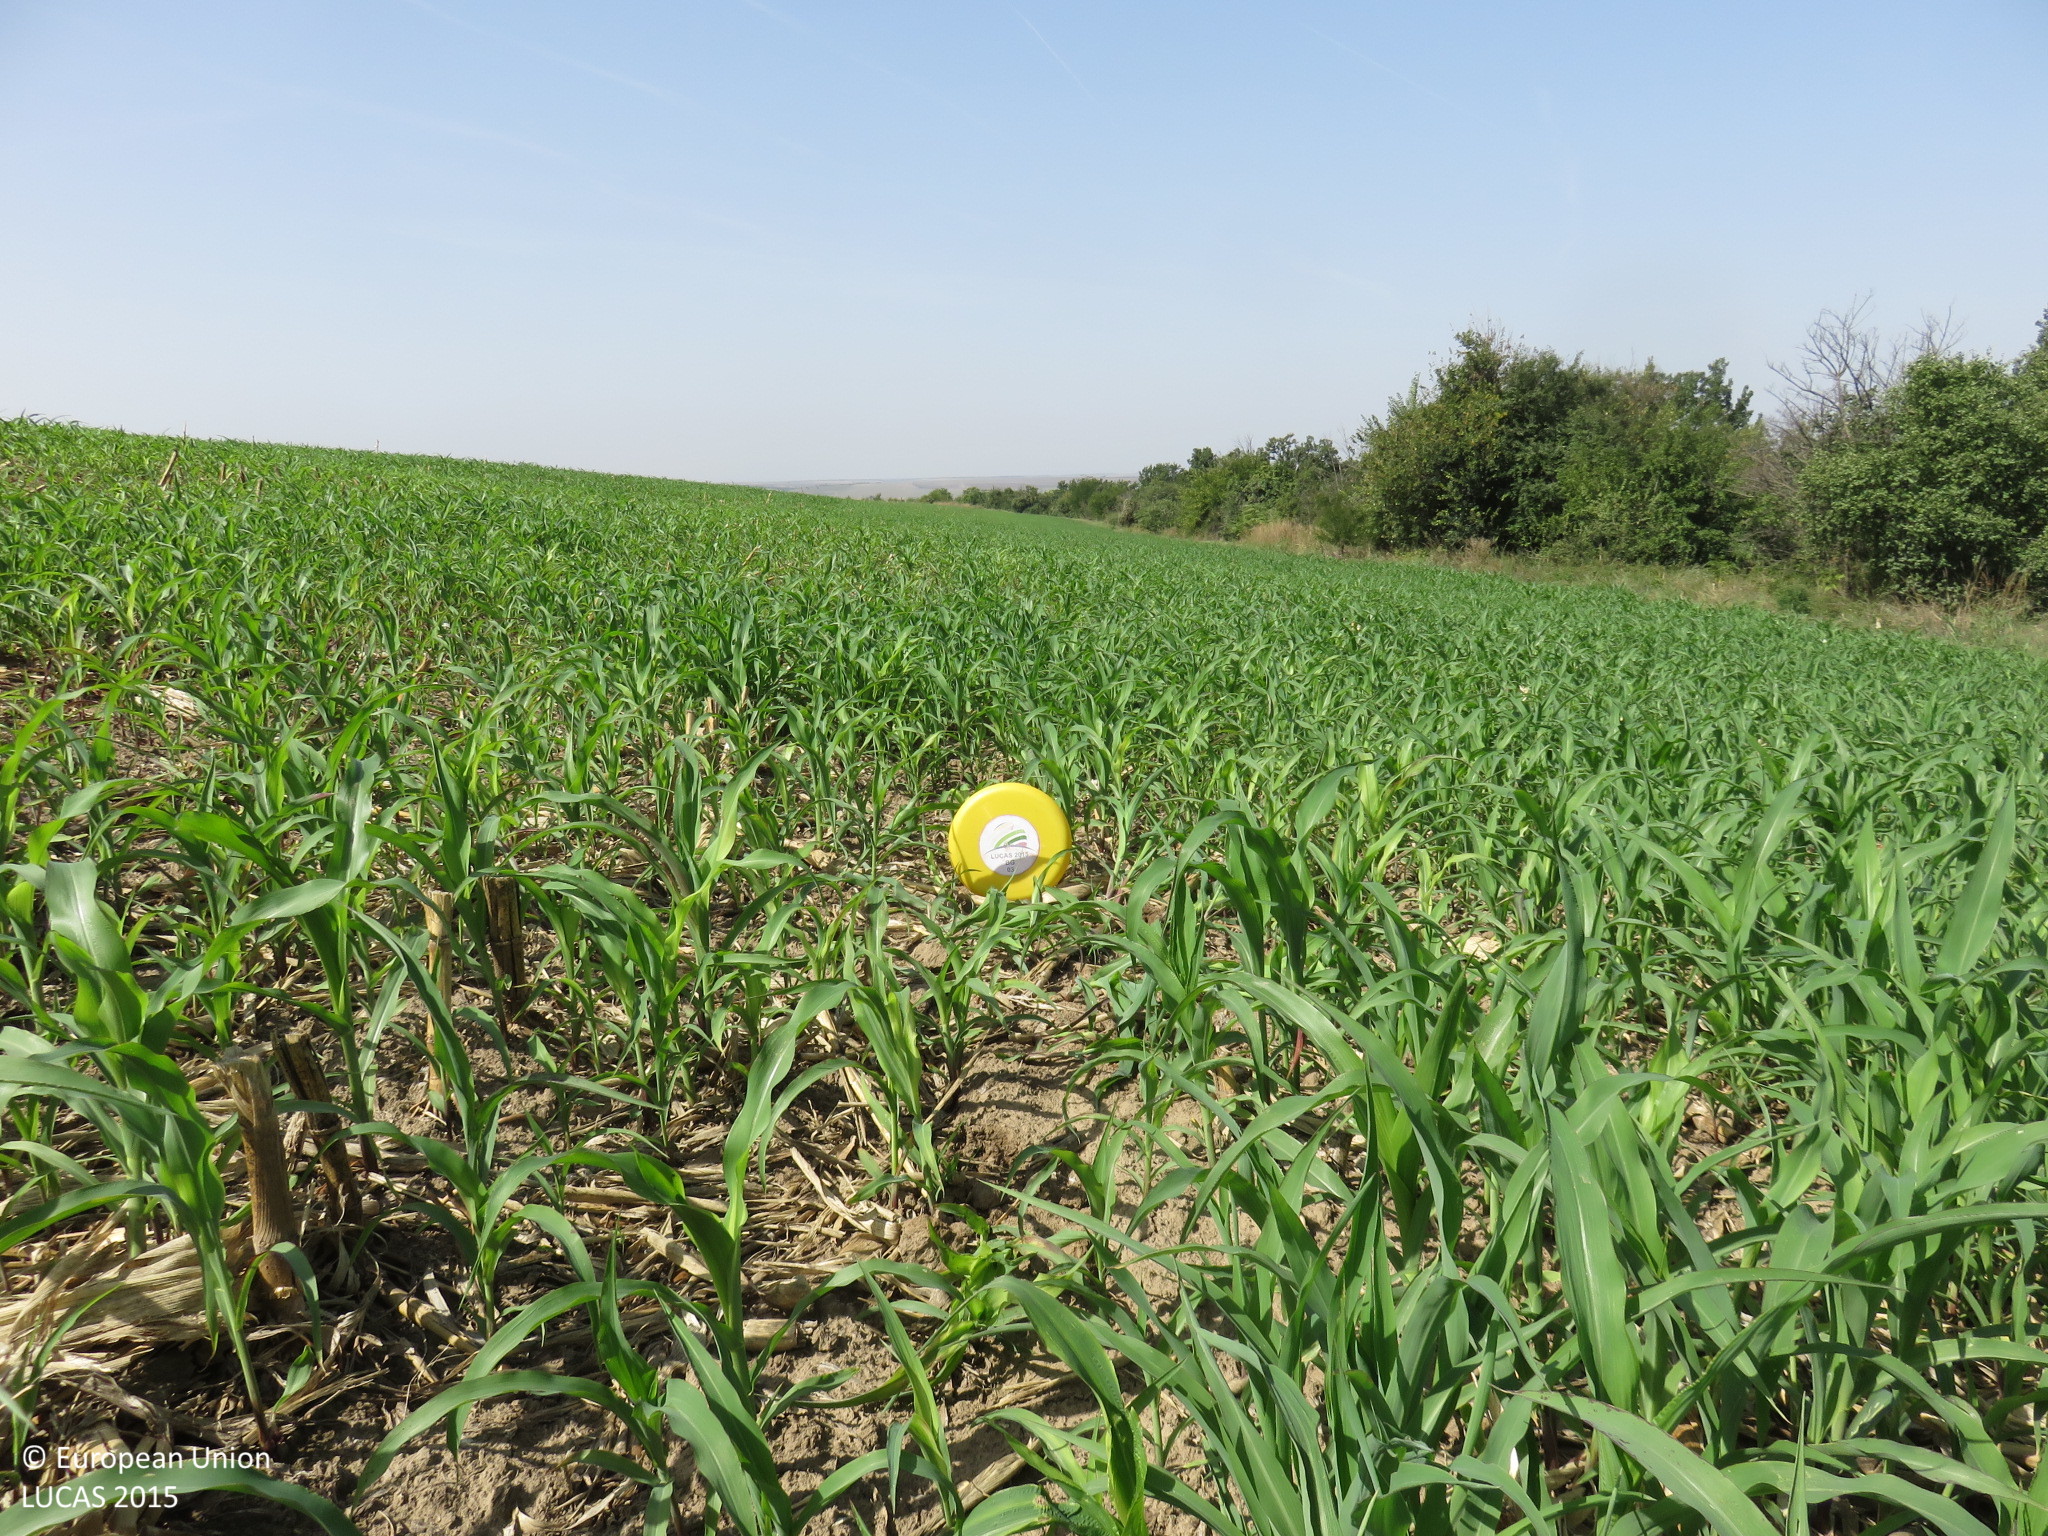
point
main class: Cropland
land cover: Maize
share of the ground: 25 - 50 %
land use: Agriculture (excluding fallow land and kitchen gardens)
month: September
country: BG
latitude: 43.5448
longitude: 24.6318
